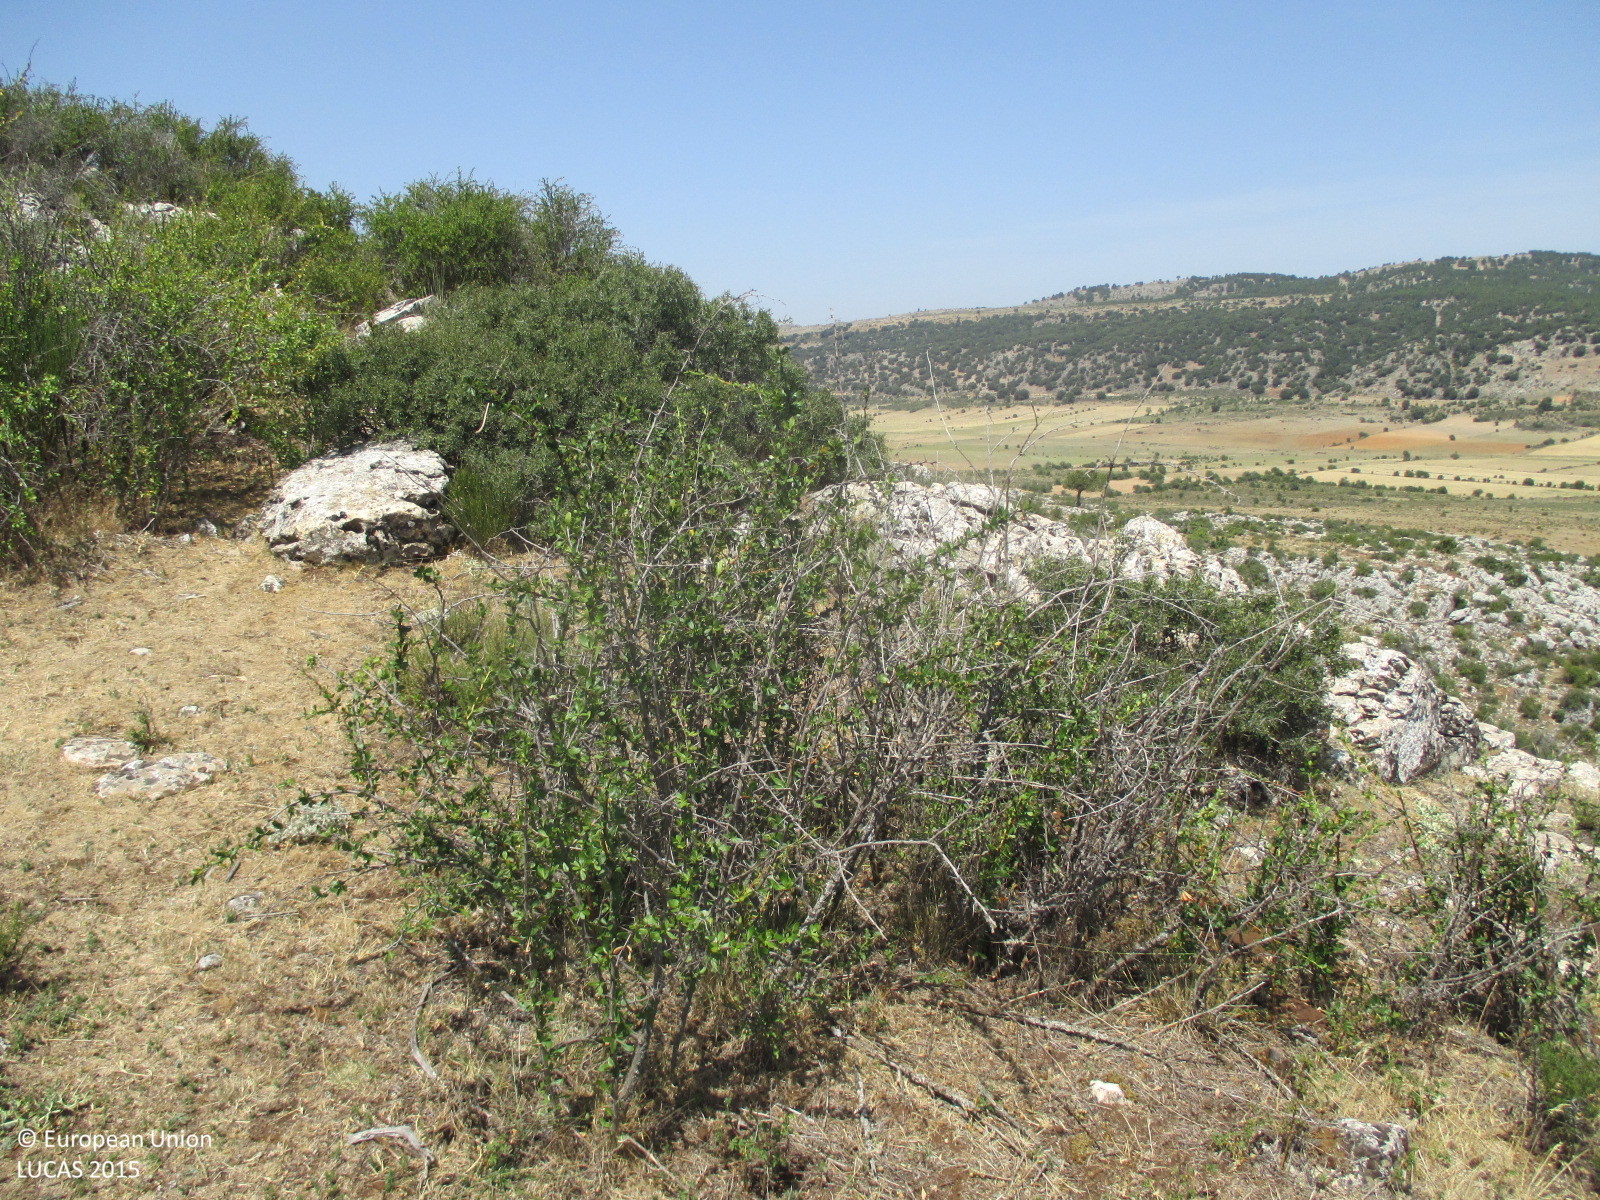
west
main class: Shrubland
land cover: Shrubland without tree cover
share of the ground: 50 - 75 %
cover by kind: shrubs 60 %, consolidated bare surface 30 %, herbaceous plants 10 %
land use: Semi-natural and natural areas not in use
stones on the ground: < 10 %
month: July
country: ES
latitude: 38.0947
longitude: -2.4793
